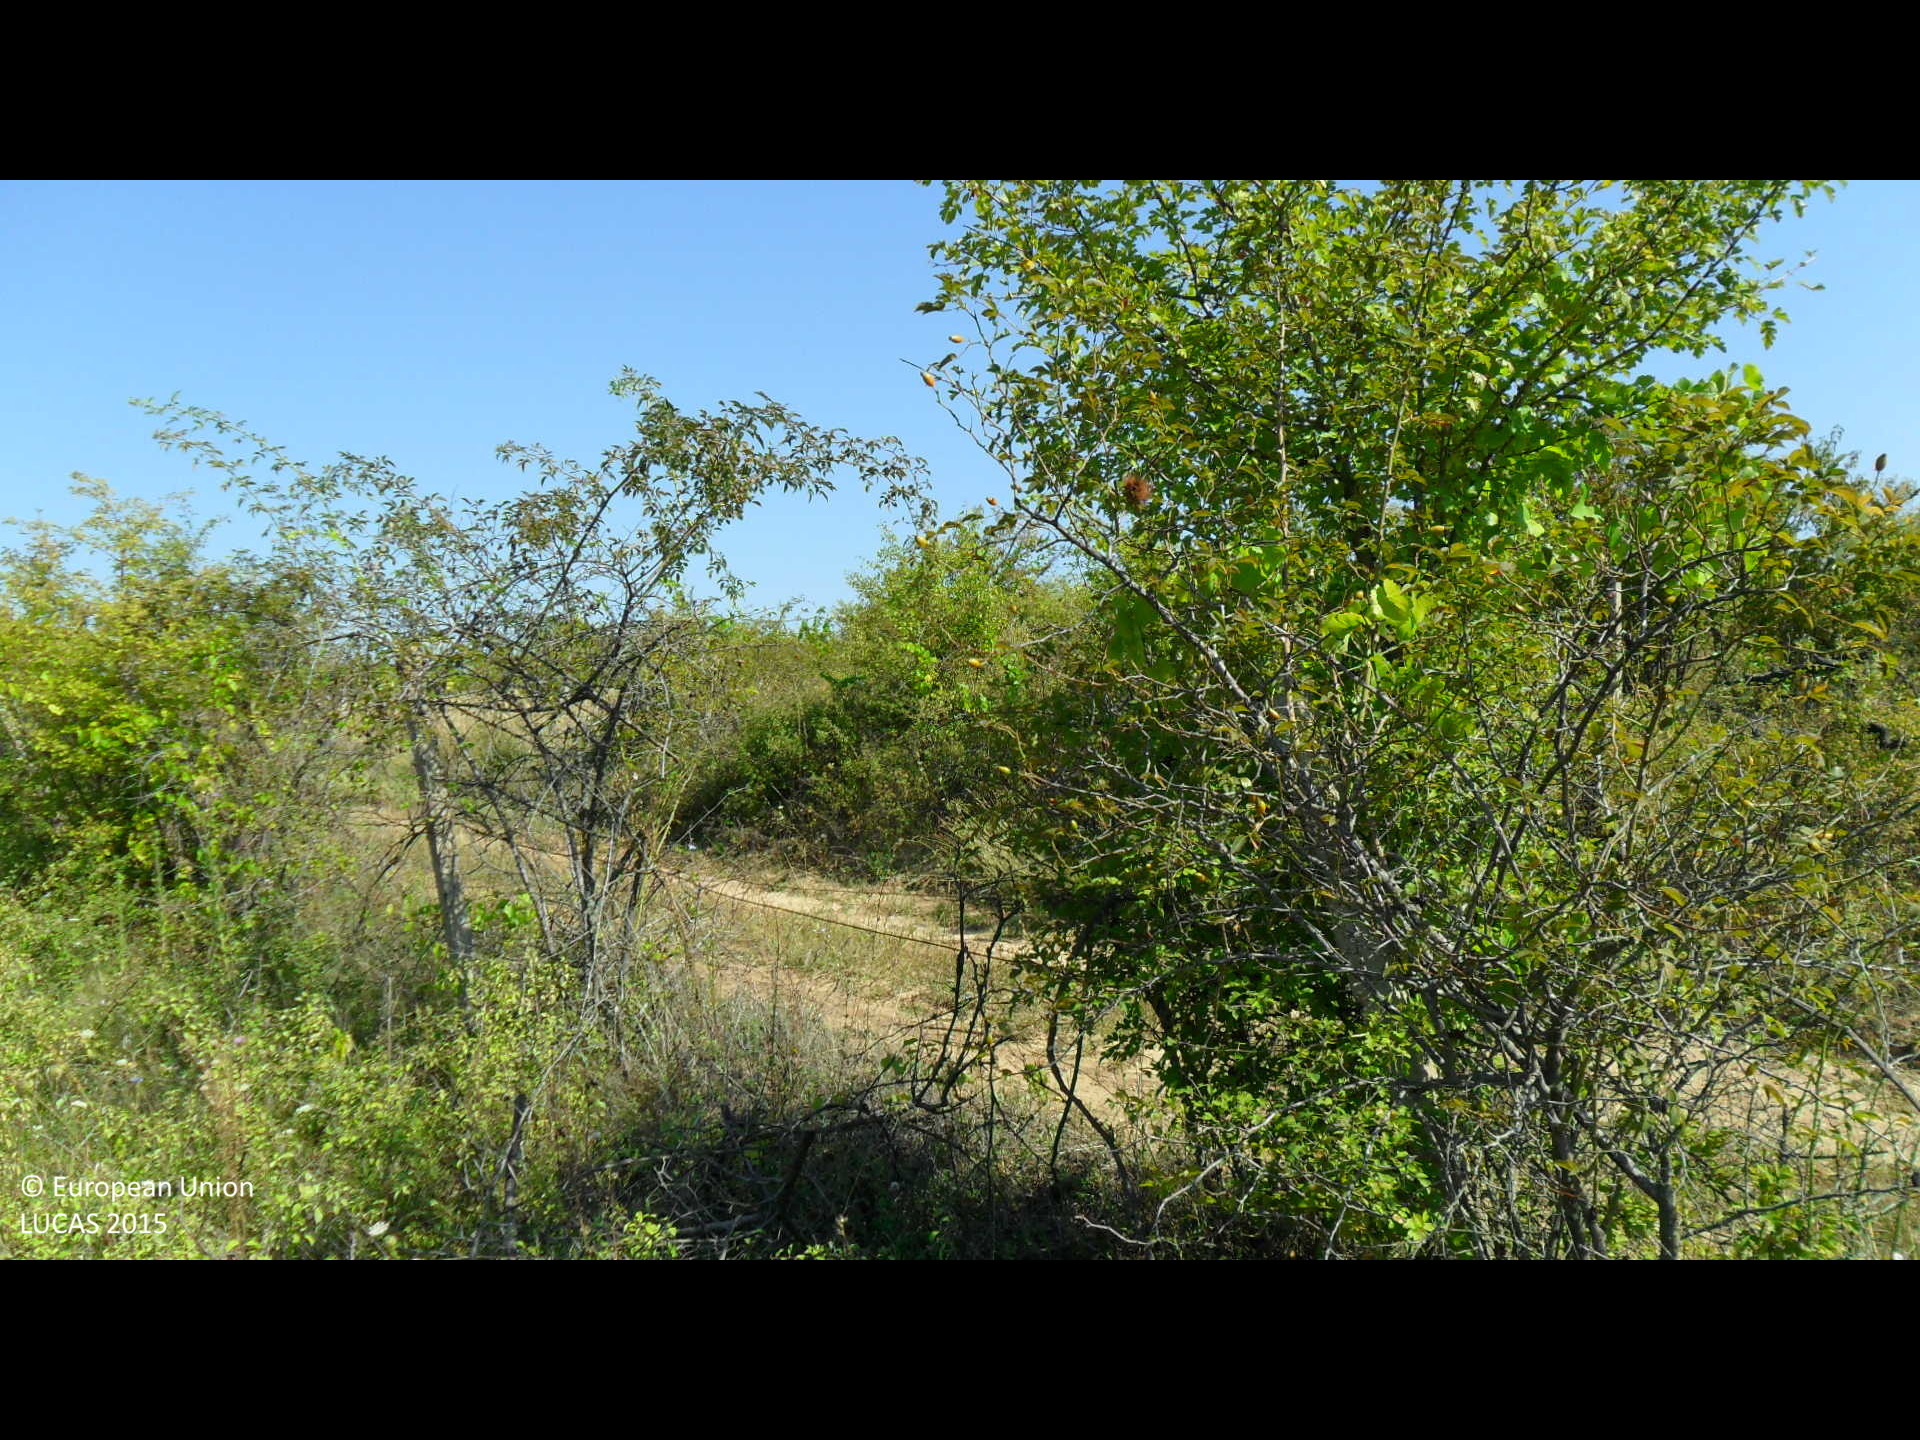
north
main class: Cropland
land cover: Vineyards
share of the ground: 50 - 75 %
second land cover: Shrubland without tree cover
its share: 50 - 75 %
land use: Abandoned areas
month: August
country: BG
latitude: 43.4922
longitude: 26.1850
